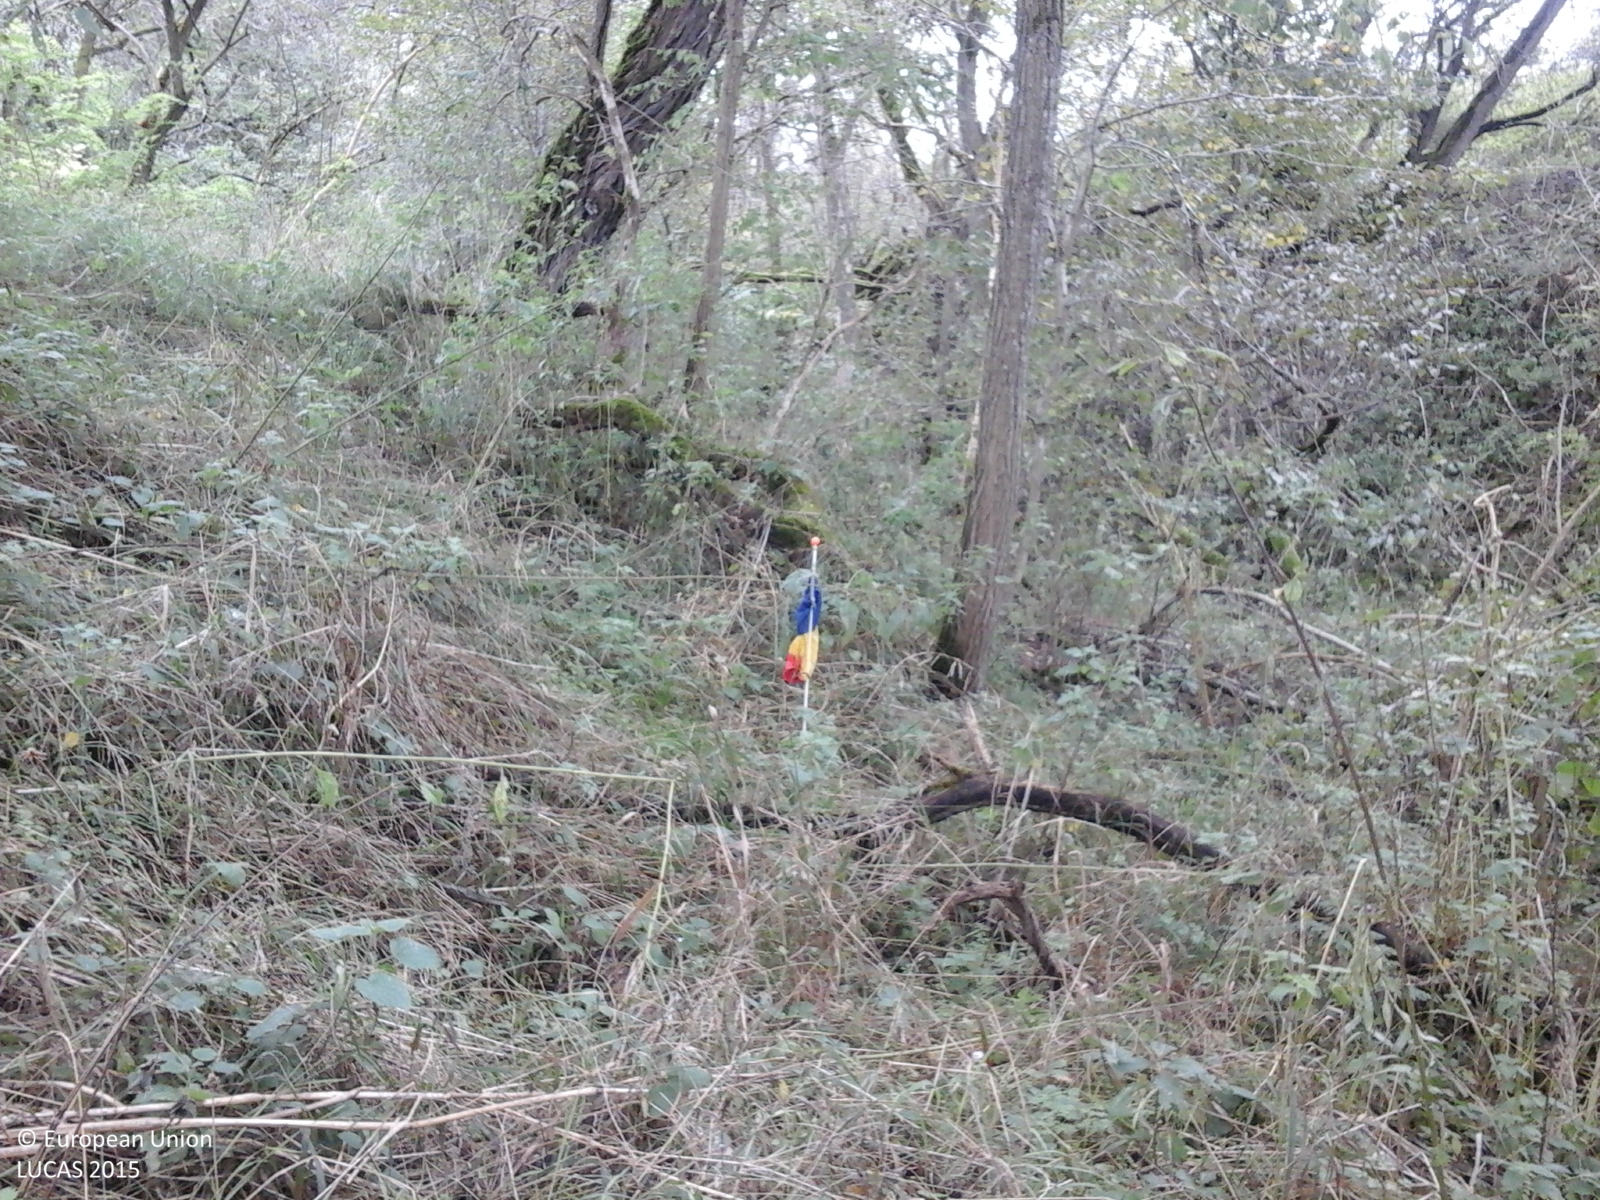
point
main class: Woodland
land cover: Broadleaved woodland
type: exotic forest
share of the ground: > 75 %
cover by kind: broadleaved forest trees 100 %
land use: Forestry
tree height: > 5 m
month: October
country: RO
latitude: 45.9045
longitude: 24.6385
